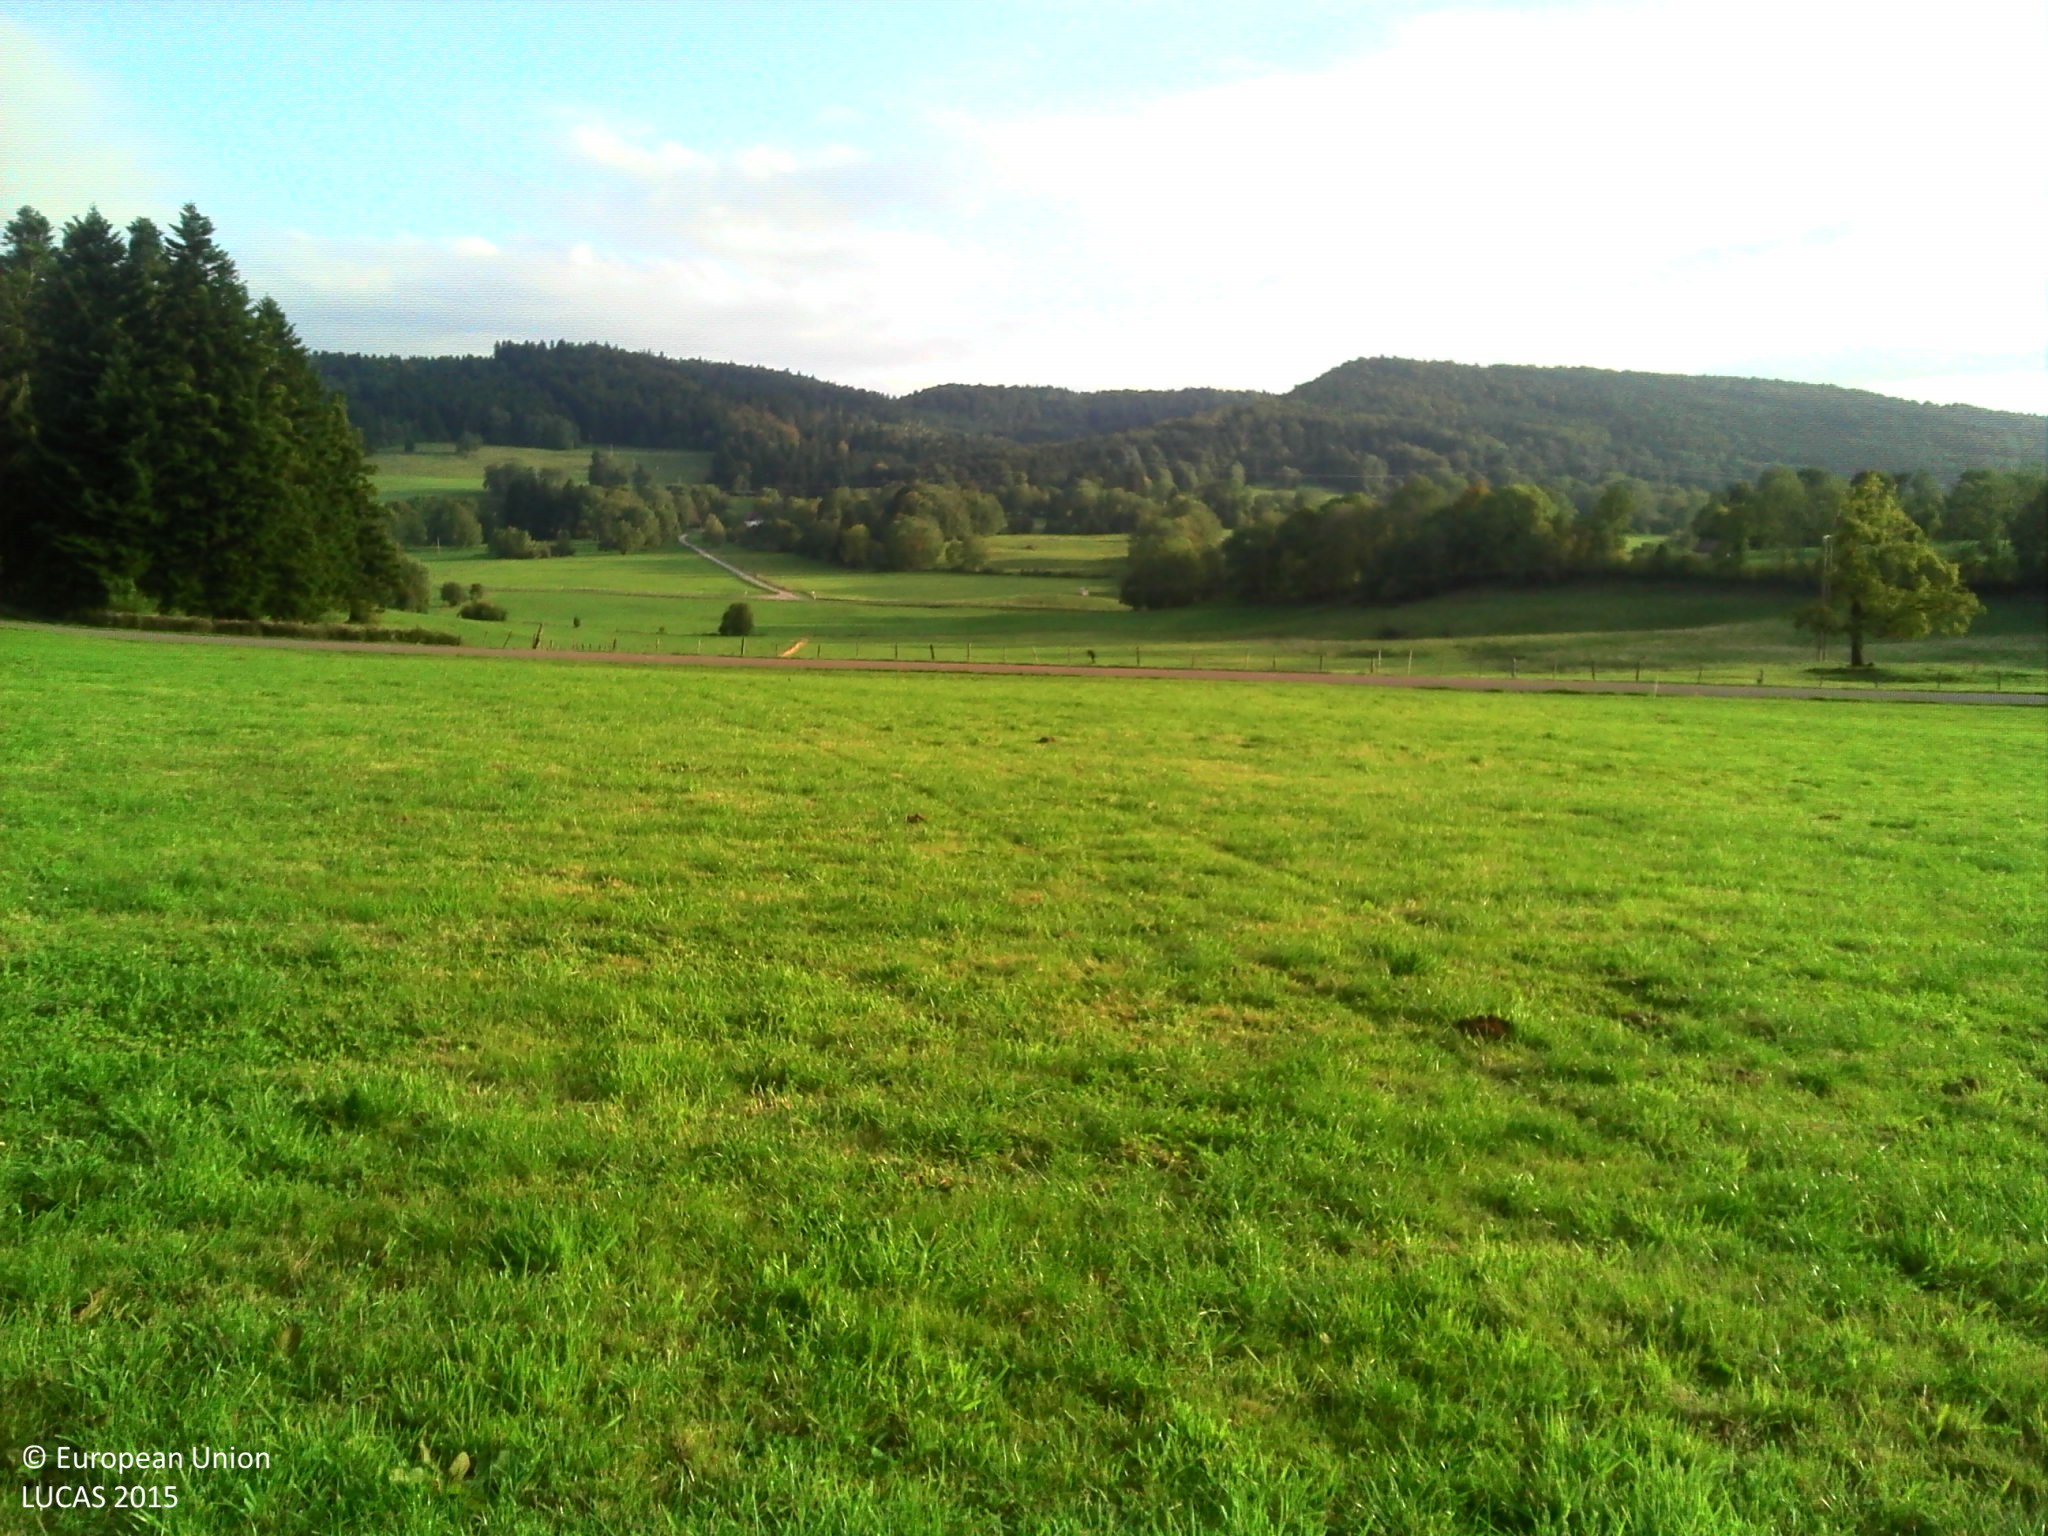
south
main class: Grassland
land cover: Grassland without tree/shrub cover
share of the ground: > 75 %
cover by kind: herbaceous plants 100 %
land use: Agriculture (excluding fallow land and kitchen gardens)
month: September
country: FR
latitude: 47.3160
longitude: 6.9195
